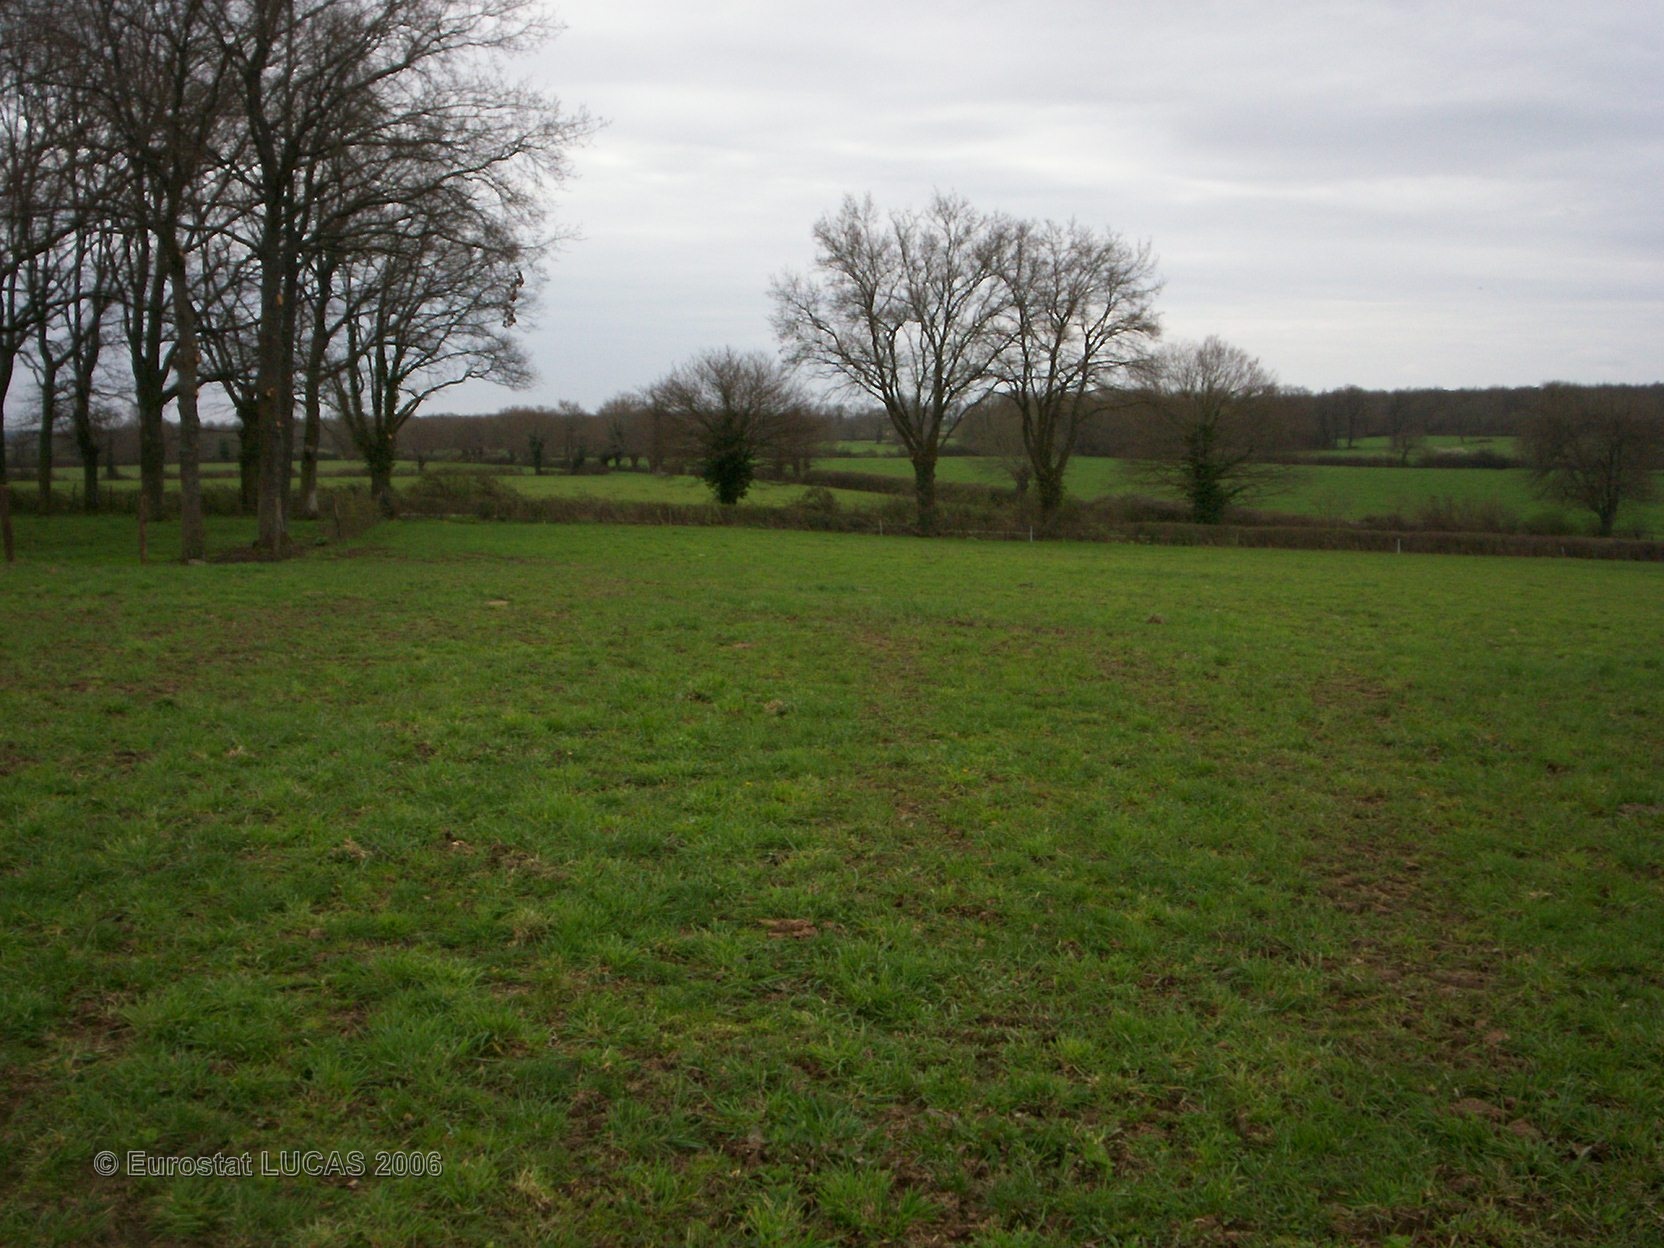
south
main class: Grassland
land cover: Grassland without tree/shrub cover
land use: Agriculture (excluding fallow land and kitchen gardens)
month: April
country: FR
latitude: 46.7085
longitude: 3.1299
